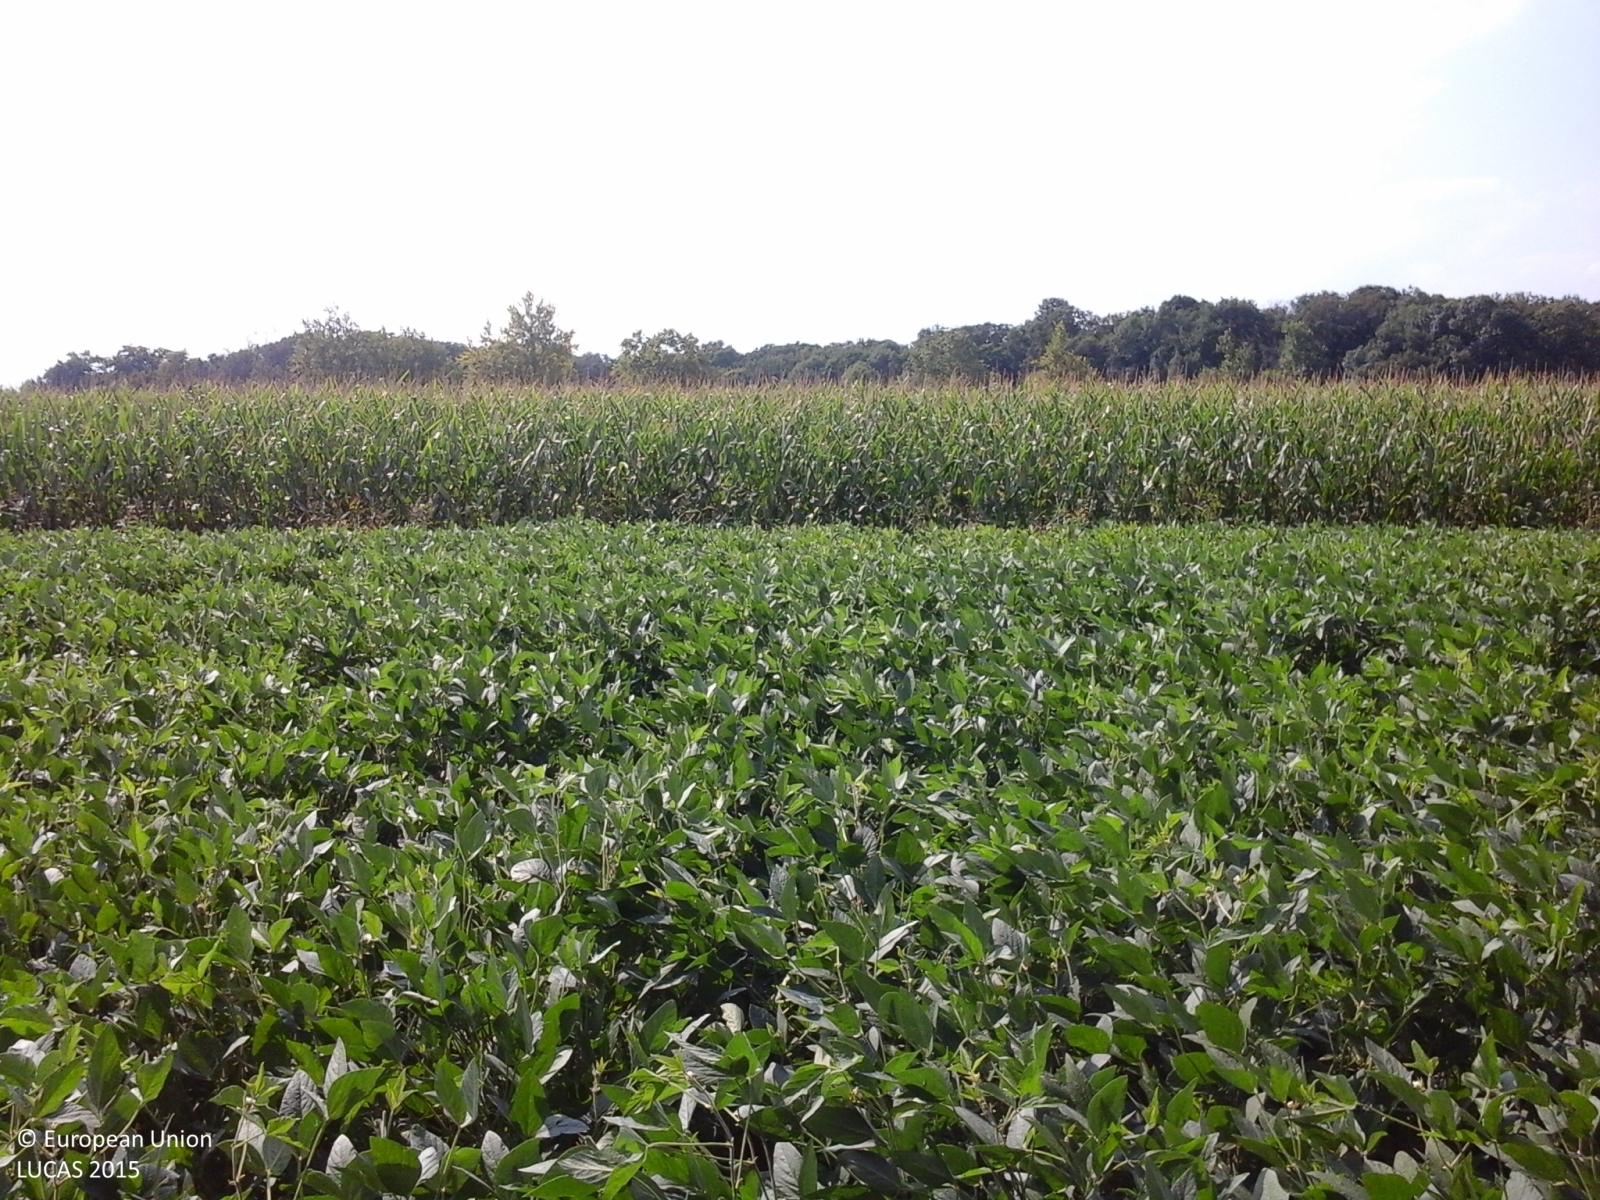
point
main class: Cropland
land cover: Maize
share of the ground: > 75 %
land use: Agriculture (excluding fallow land and kitchen gardens)
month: June
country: IT
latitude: 45.7620
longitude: 12.5551
